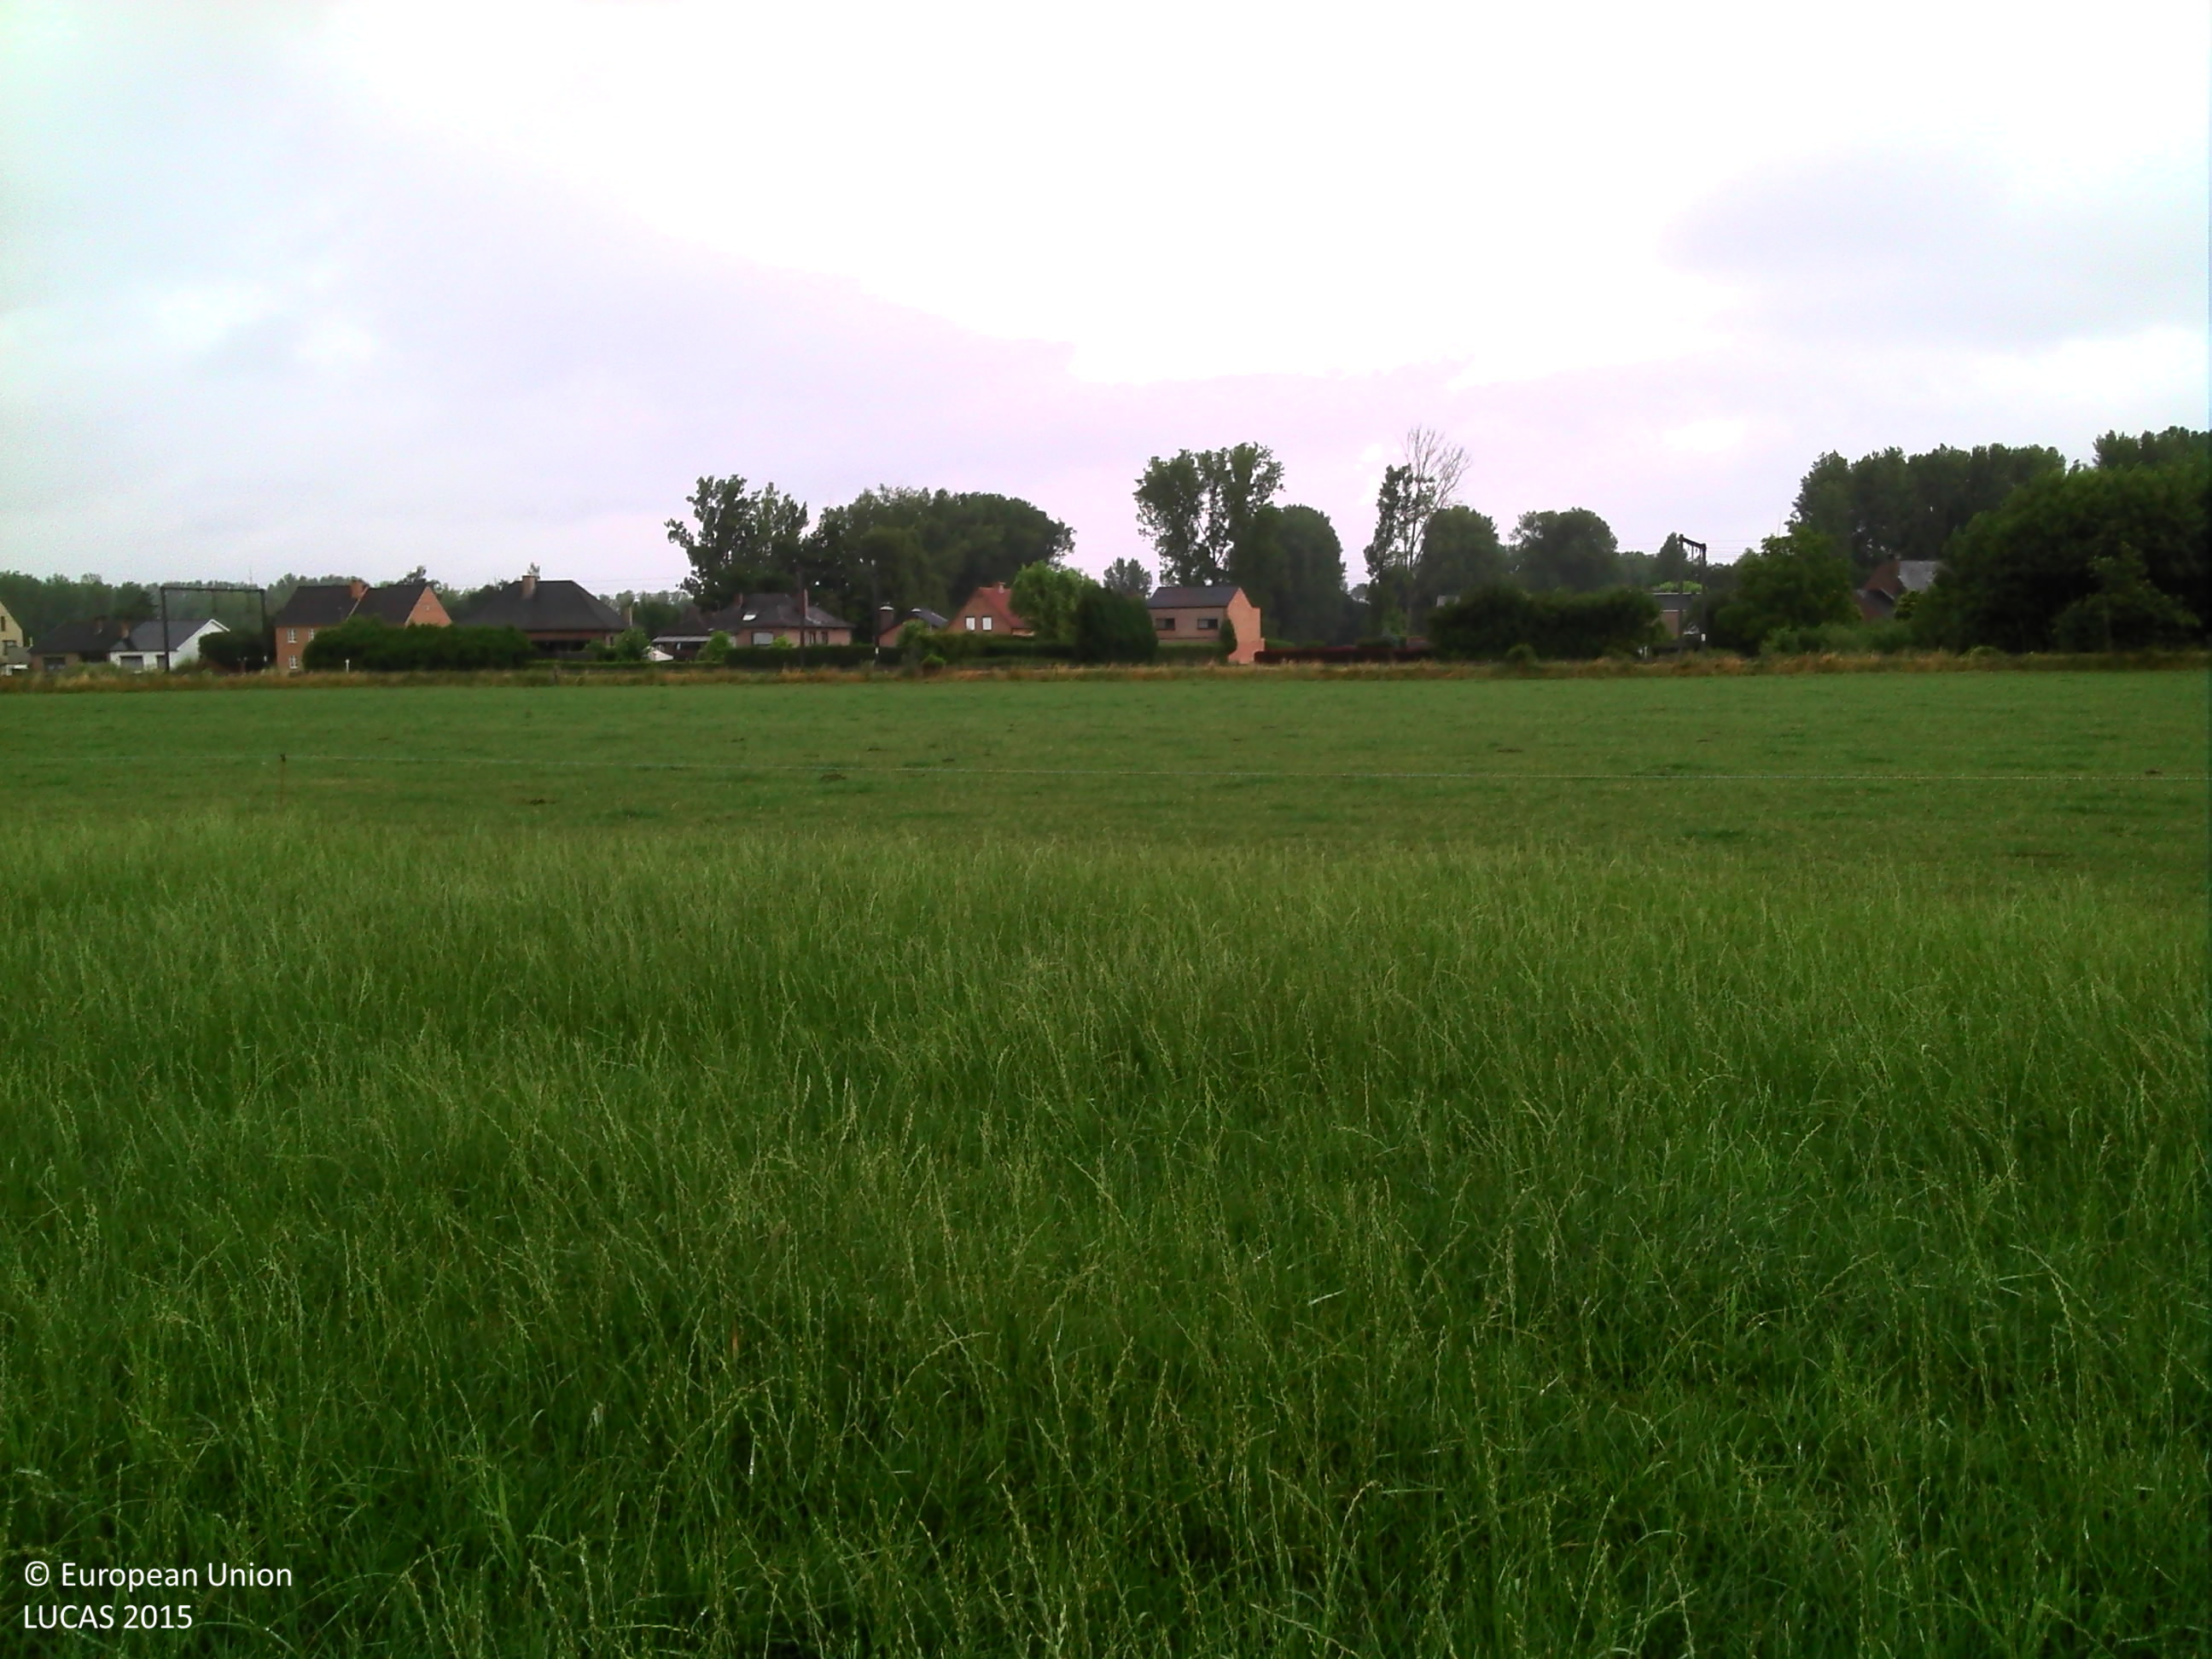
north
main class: Cropland
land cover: Temporary grasslands
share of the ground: > 75 %
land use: Agriculture (excluding fallow land and kitchen gardens)
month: July
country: BE
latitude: 50.8875
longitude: 5.4919
